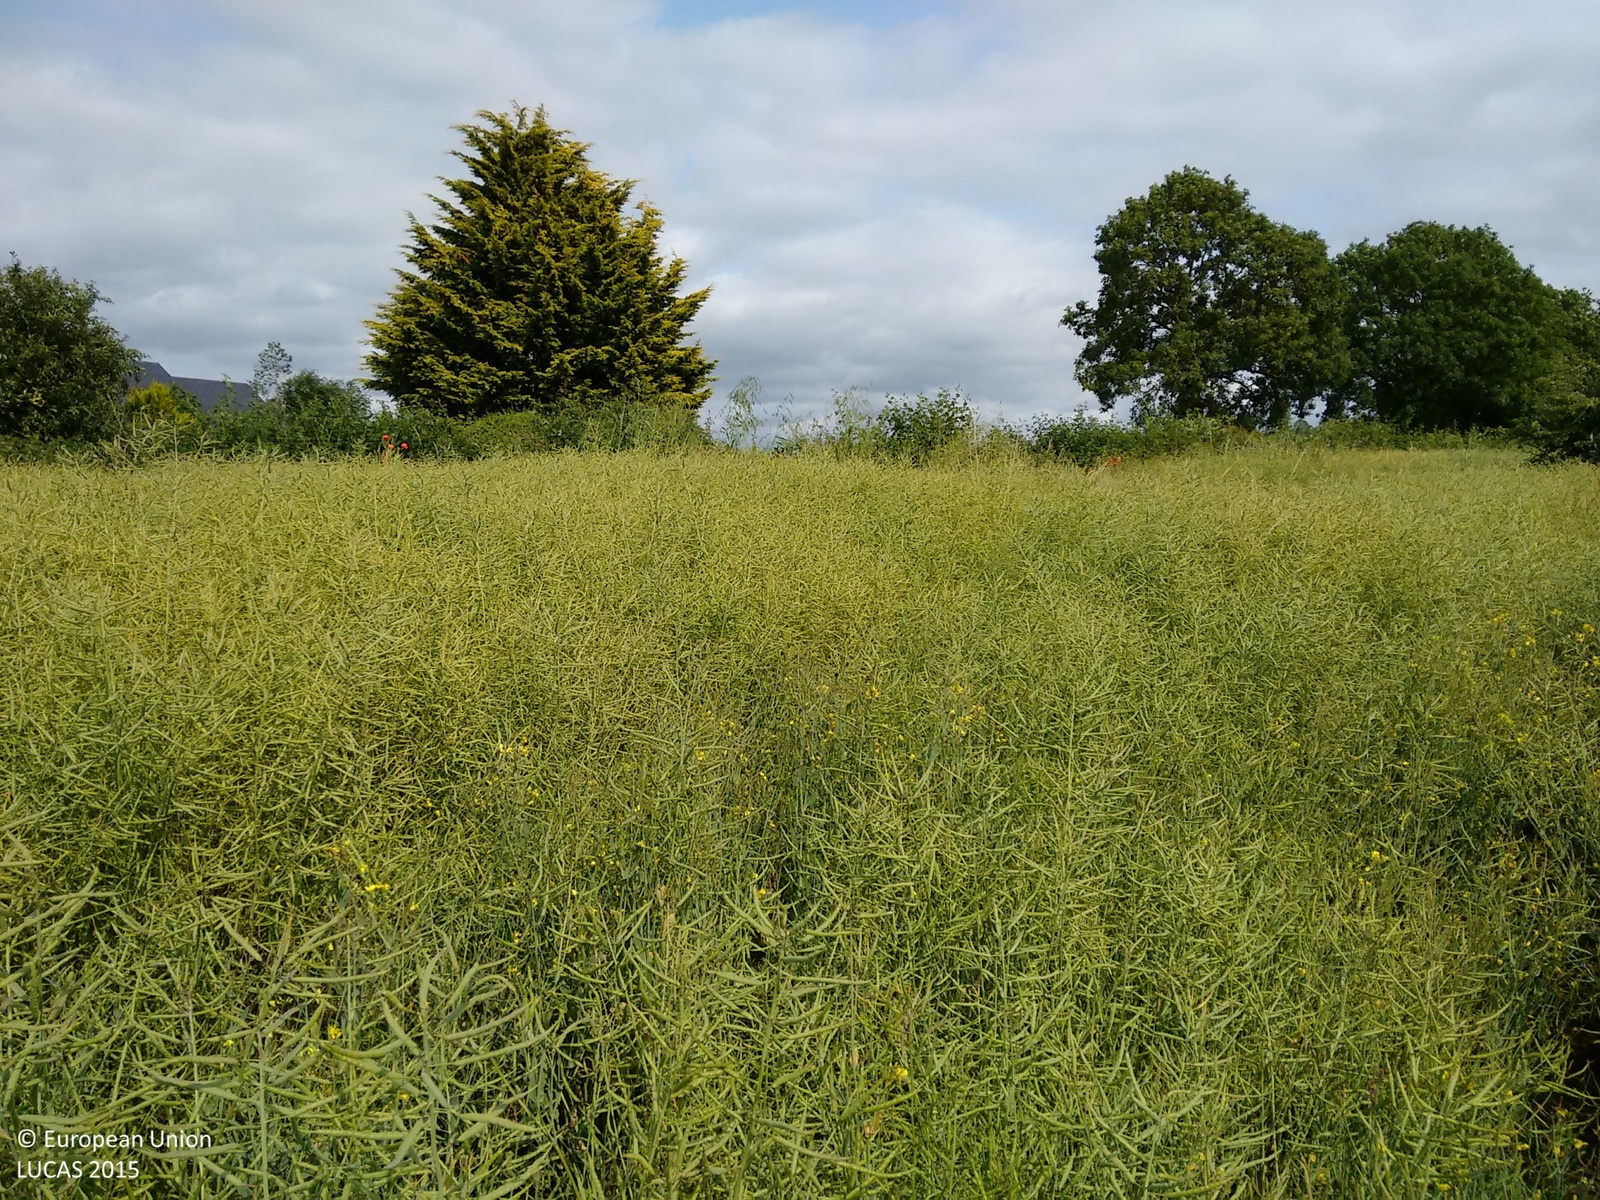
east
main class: Cropland
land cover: Rape and turnip rape
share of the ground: > 75 %
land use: Agriculture (excluding fallow land and kitchen gardens)
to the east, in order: Rape and turnip rape; Grass margins; Managed hedges; Paved roads, cycling and walking lanes; Grass margins; Managed hedges; Common wheat
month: July
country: IE
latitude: 53.0745
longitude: -6.8400
